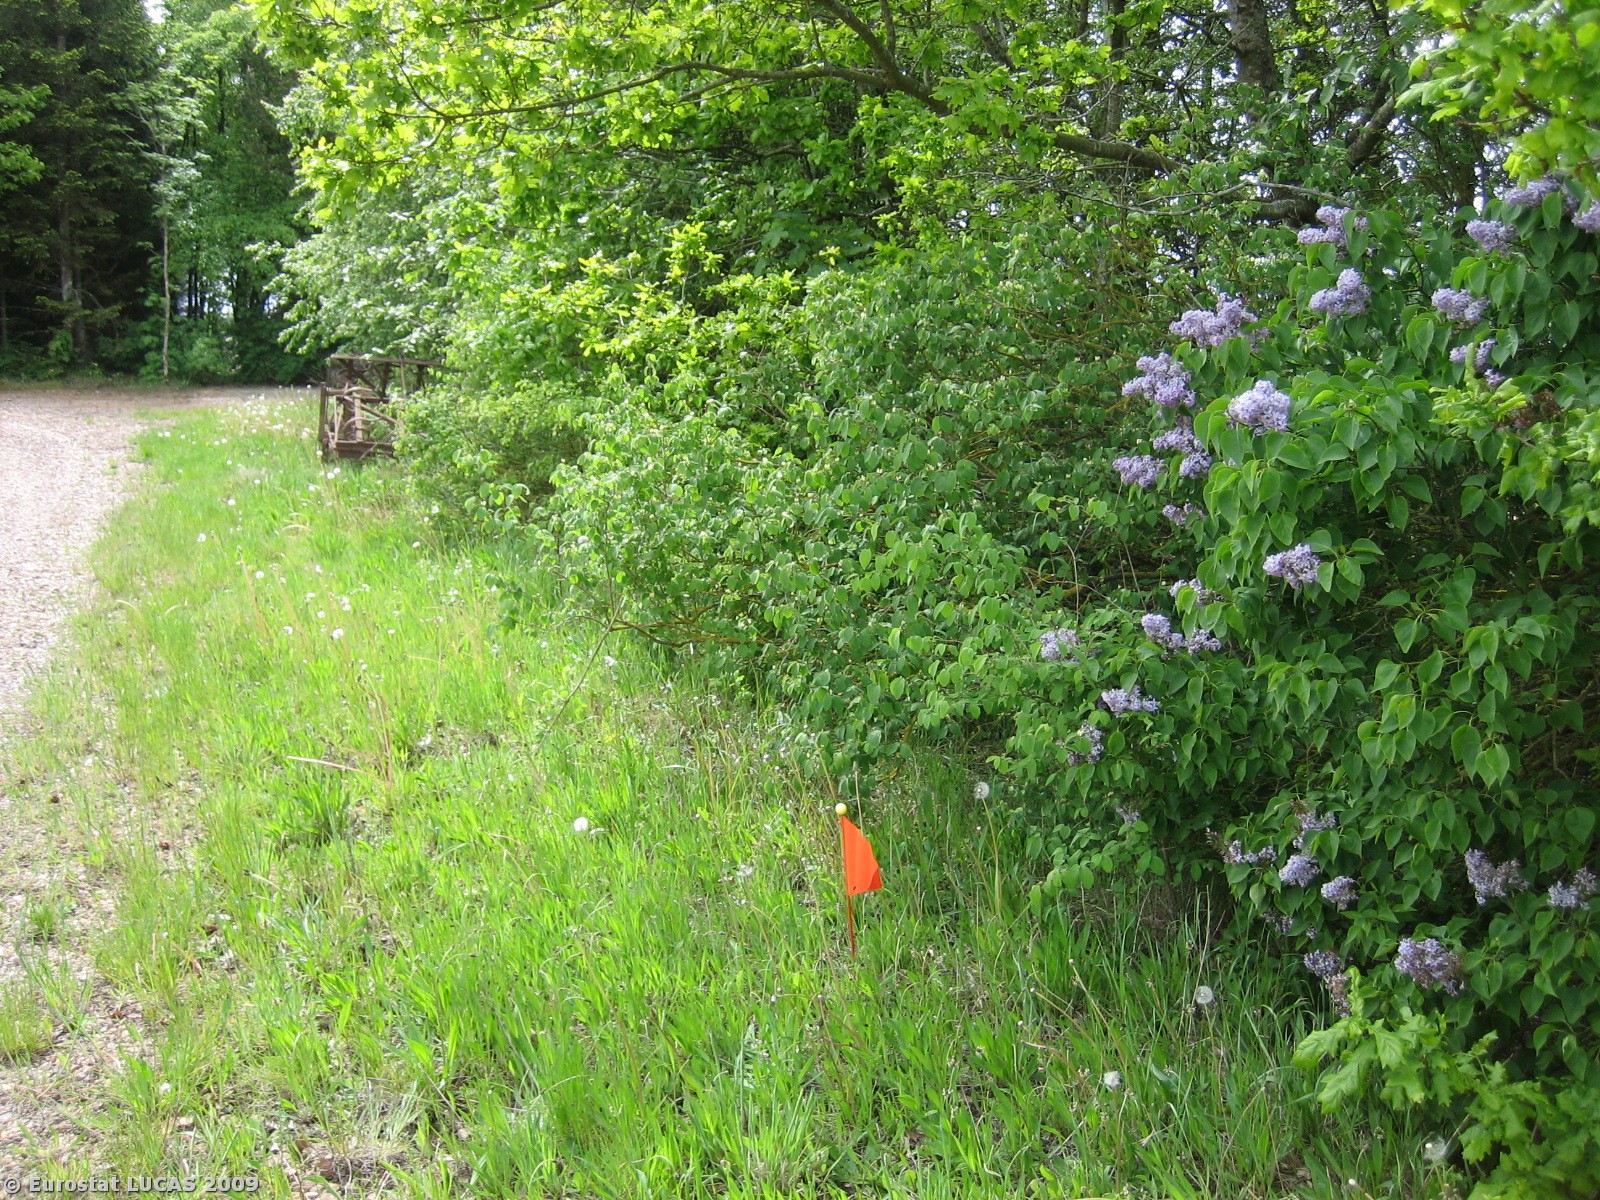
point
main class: Grassland
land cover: Spontaneously vegetated surfaces
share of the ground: 50 - 75 %
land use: Unused
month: May
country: DK
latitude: 56.2037
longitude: 9.2755
